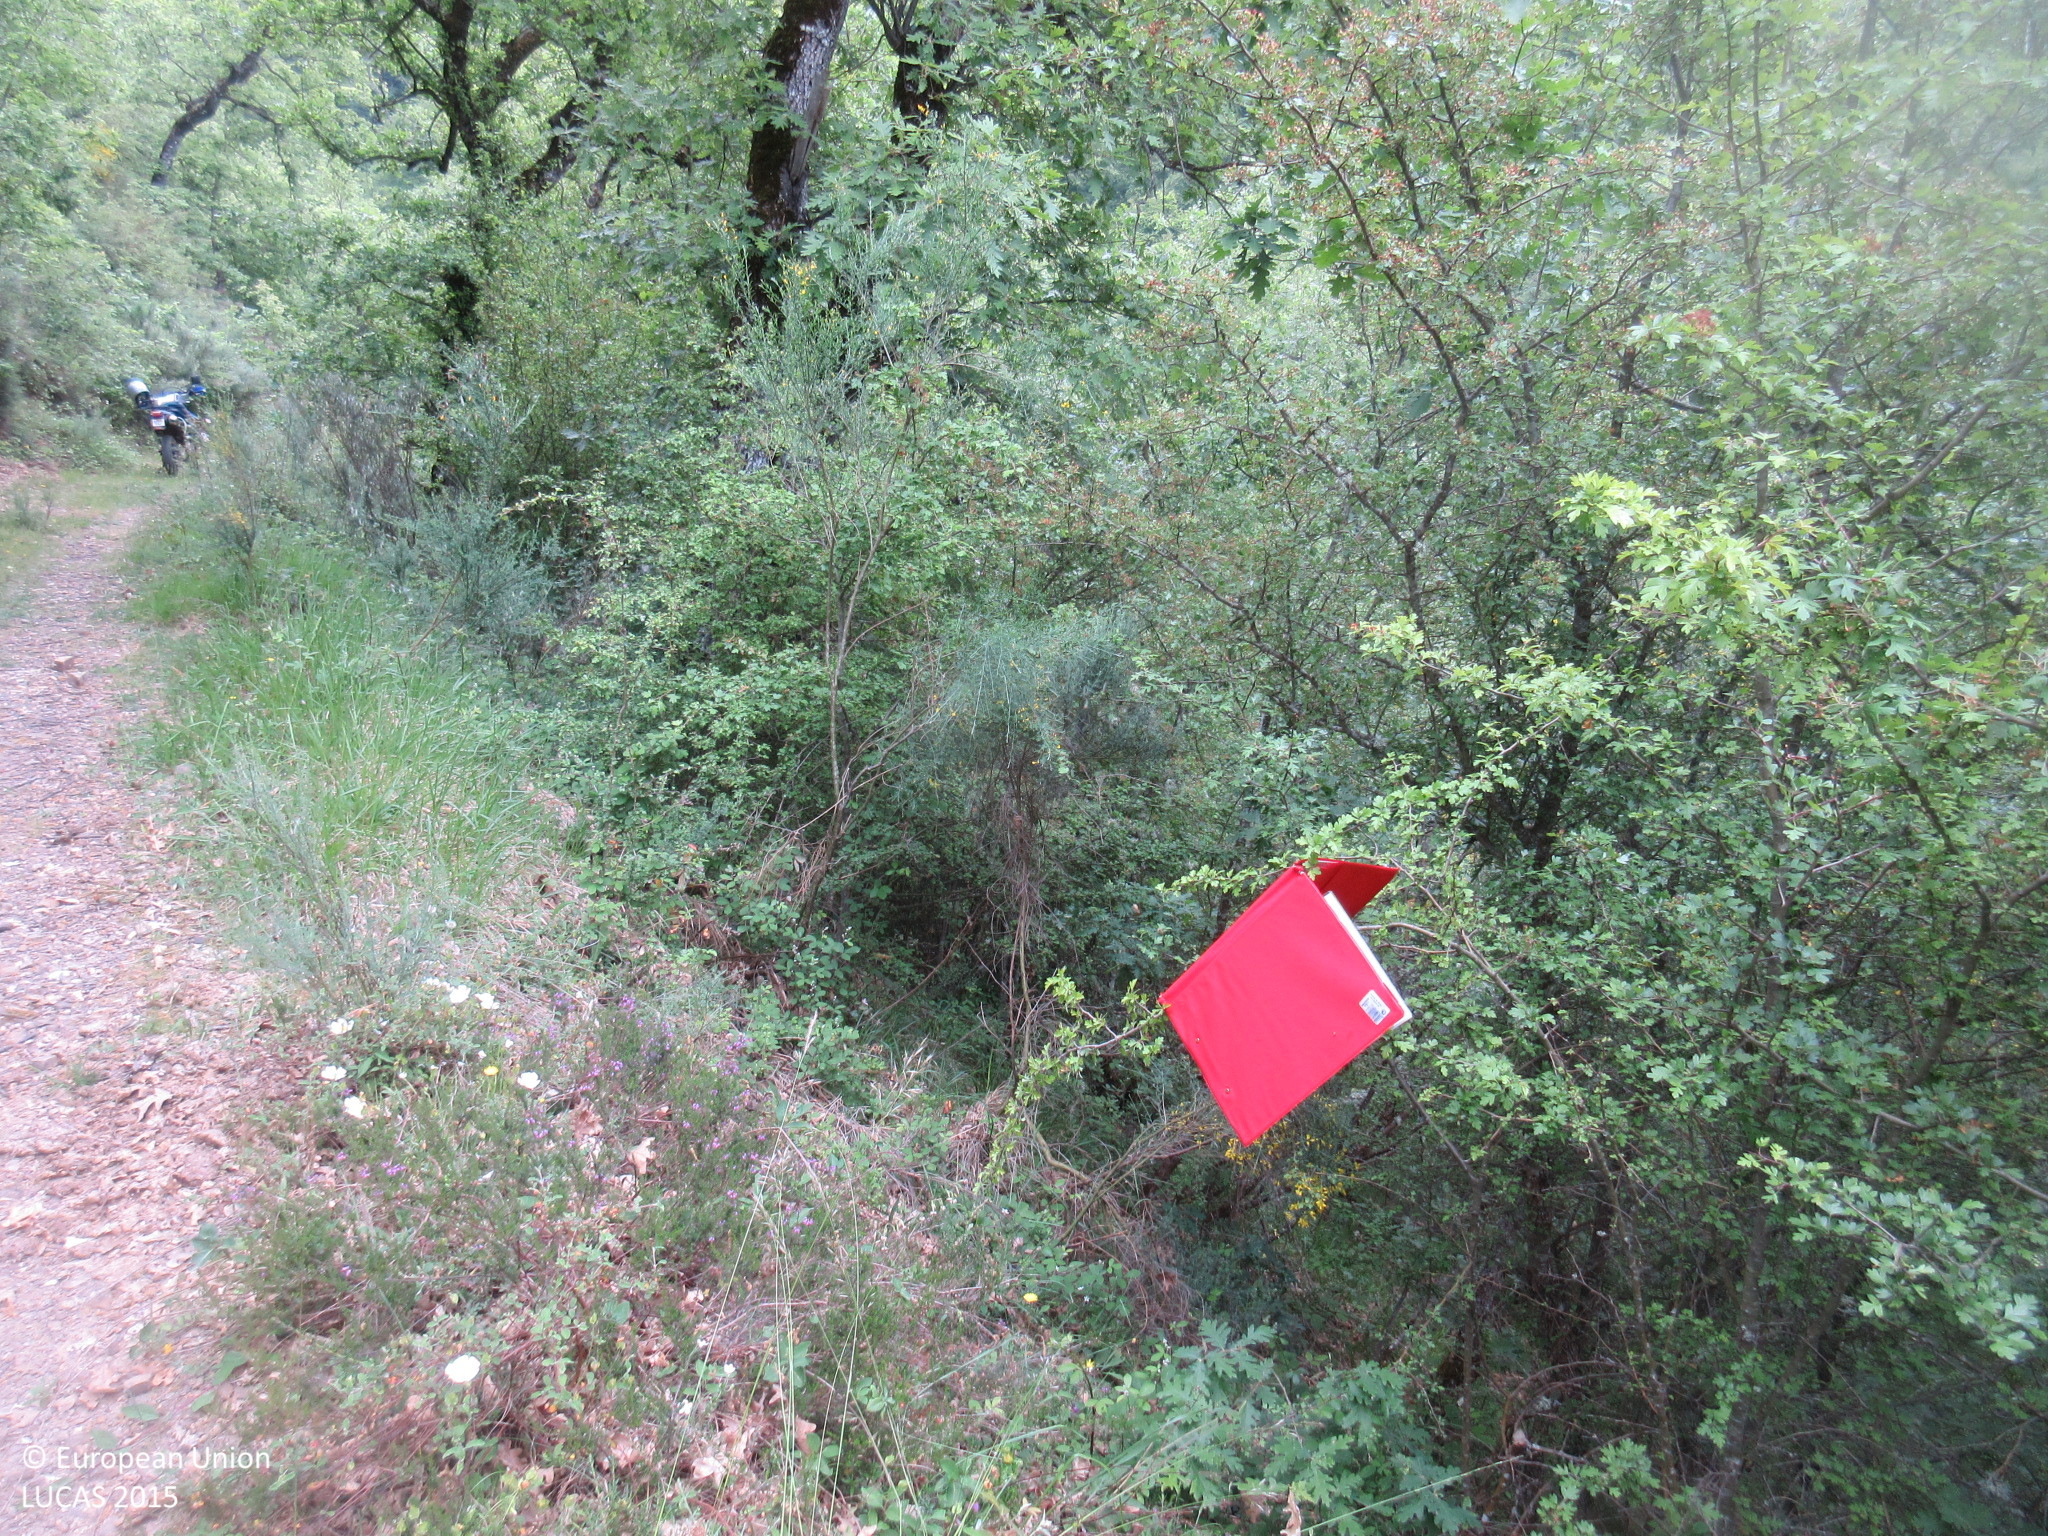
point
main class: Woodland
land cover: Broadleaved woodland
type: thermophilous deciduous forest
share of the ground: > 75 %
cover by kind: broadleaved forest trees 95 %, unconsolidated bare surface 5 %
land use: Semi-natural and natural areas not in use
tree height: > 5 m
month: June
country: ES
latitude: 43.1385
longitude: -4.5289
